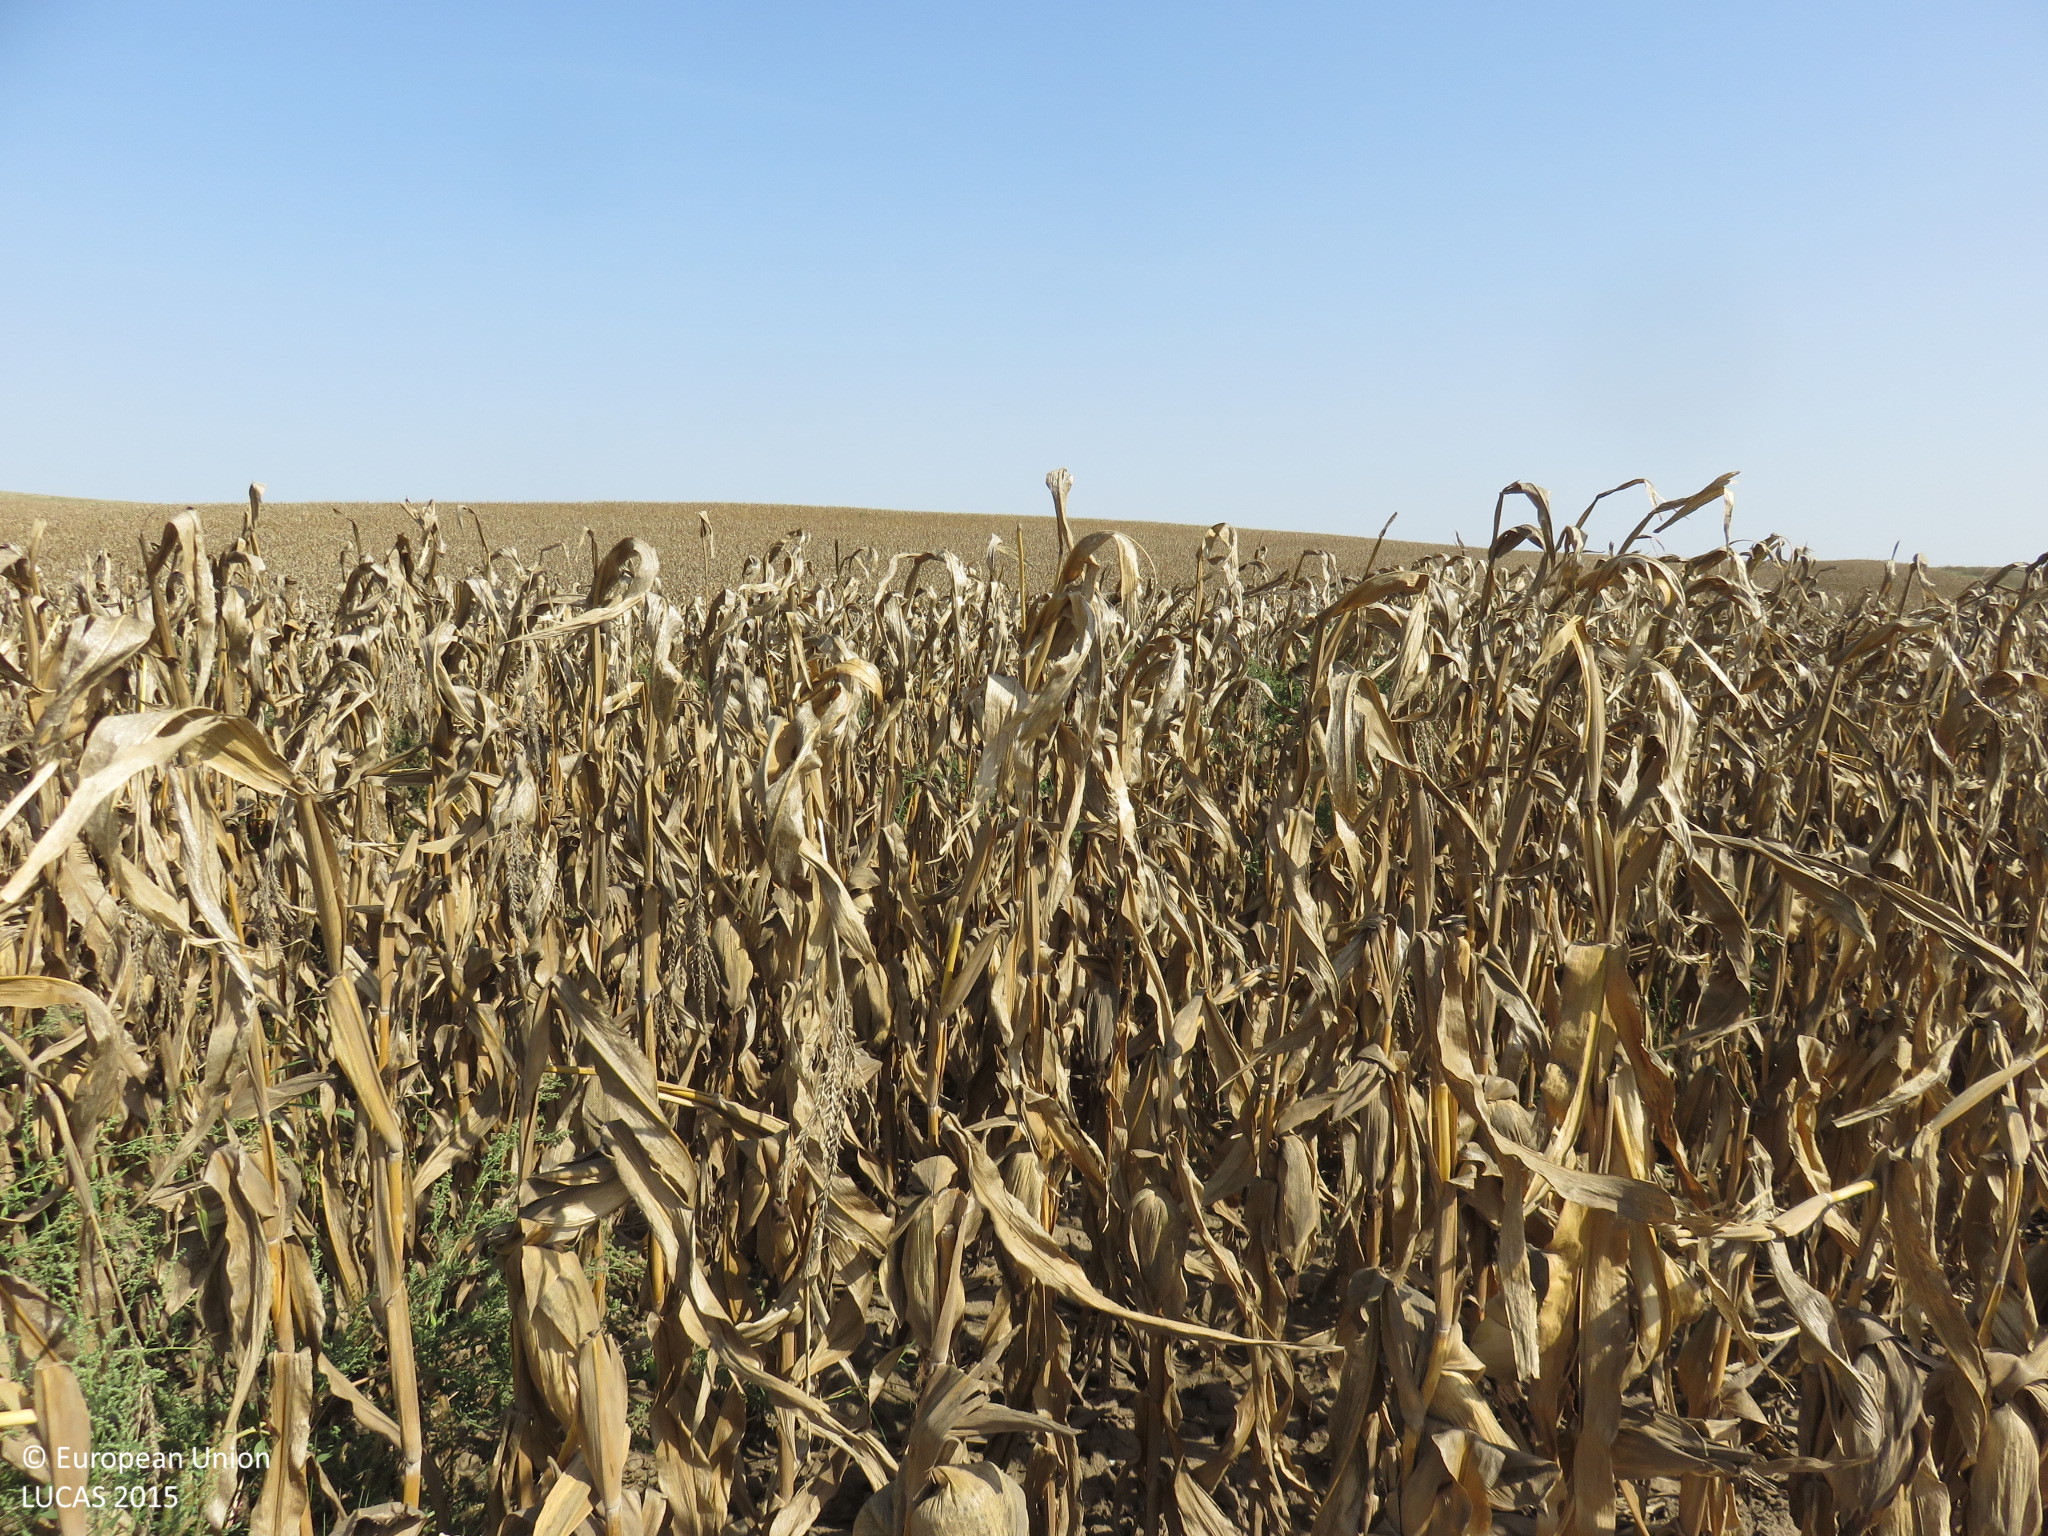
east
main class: Cropland
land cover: Maize
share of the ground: > 75 %
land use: Agriculture (excluding fallow land and kitchen gardens)
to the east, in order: Maize
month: September
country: BG
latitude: 43.5518
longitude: 24.5832
